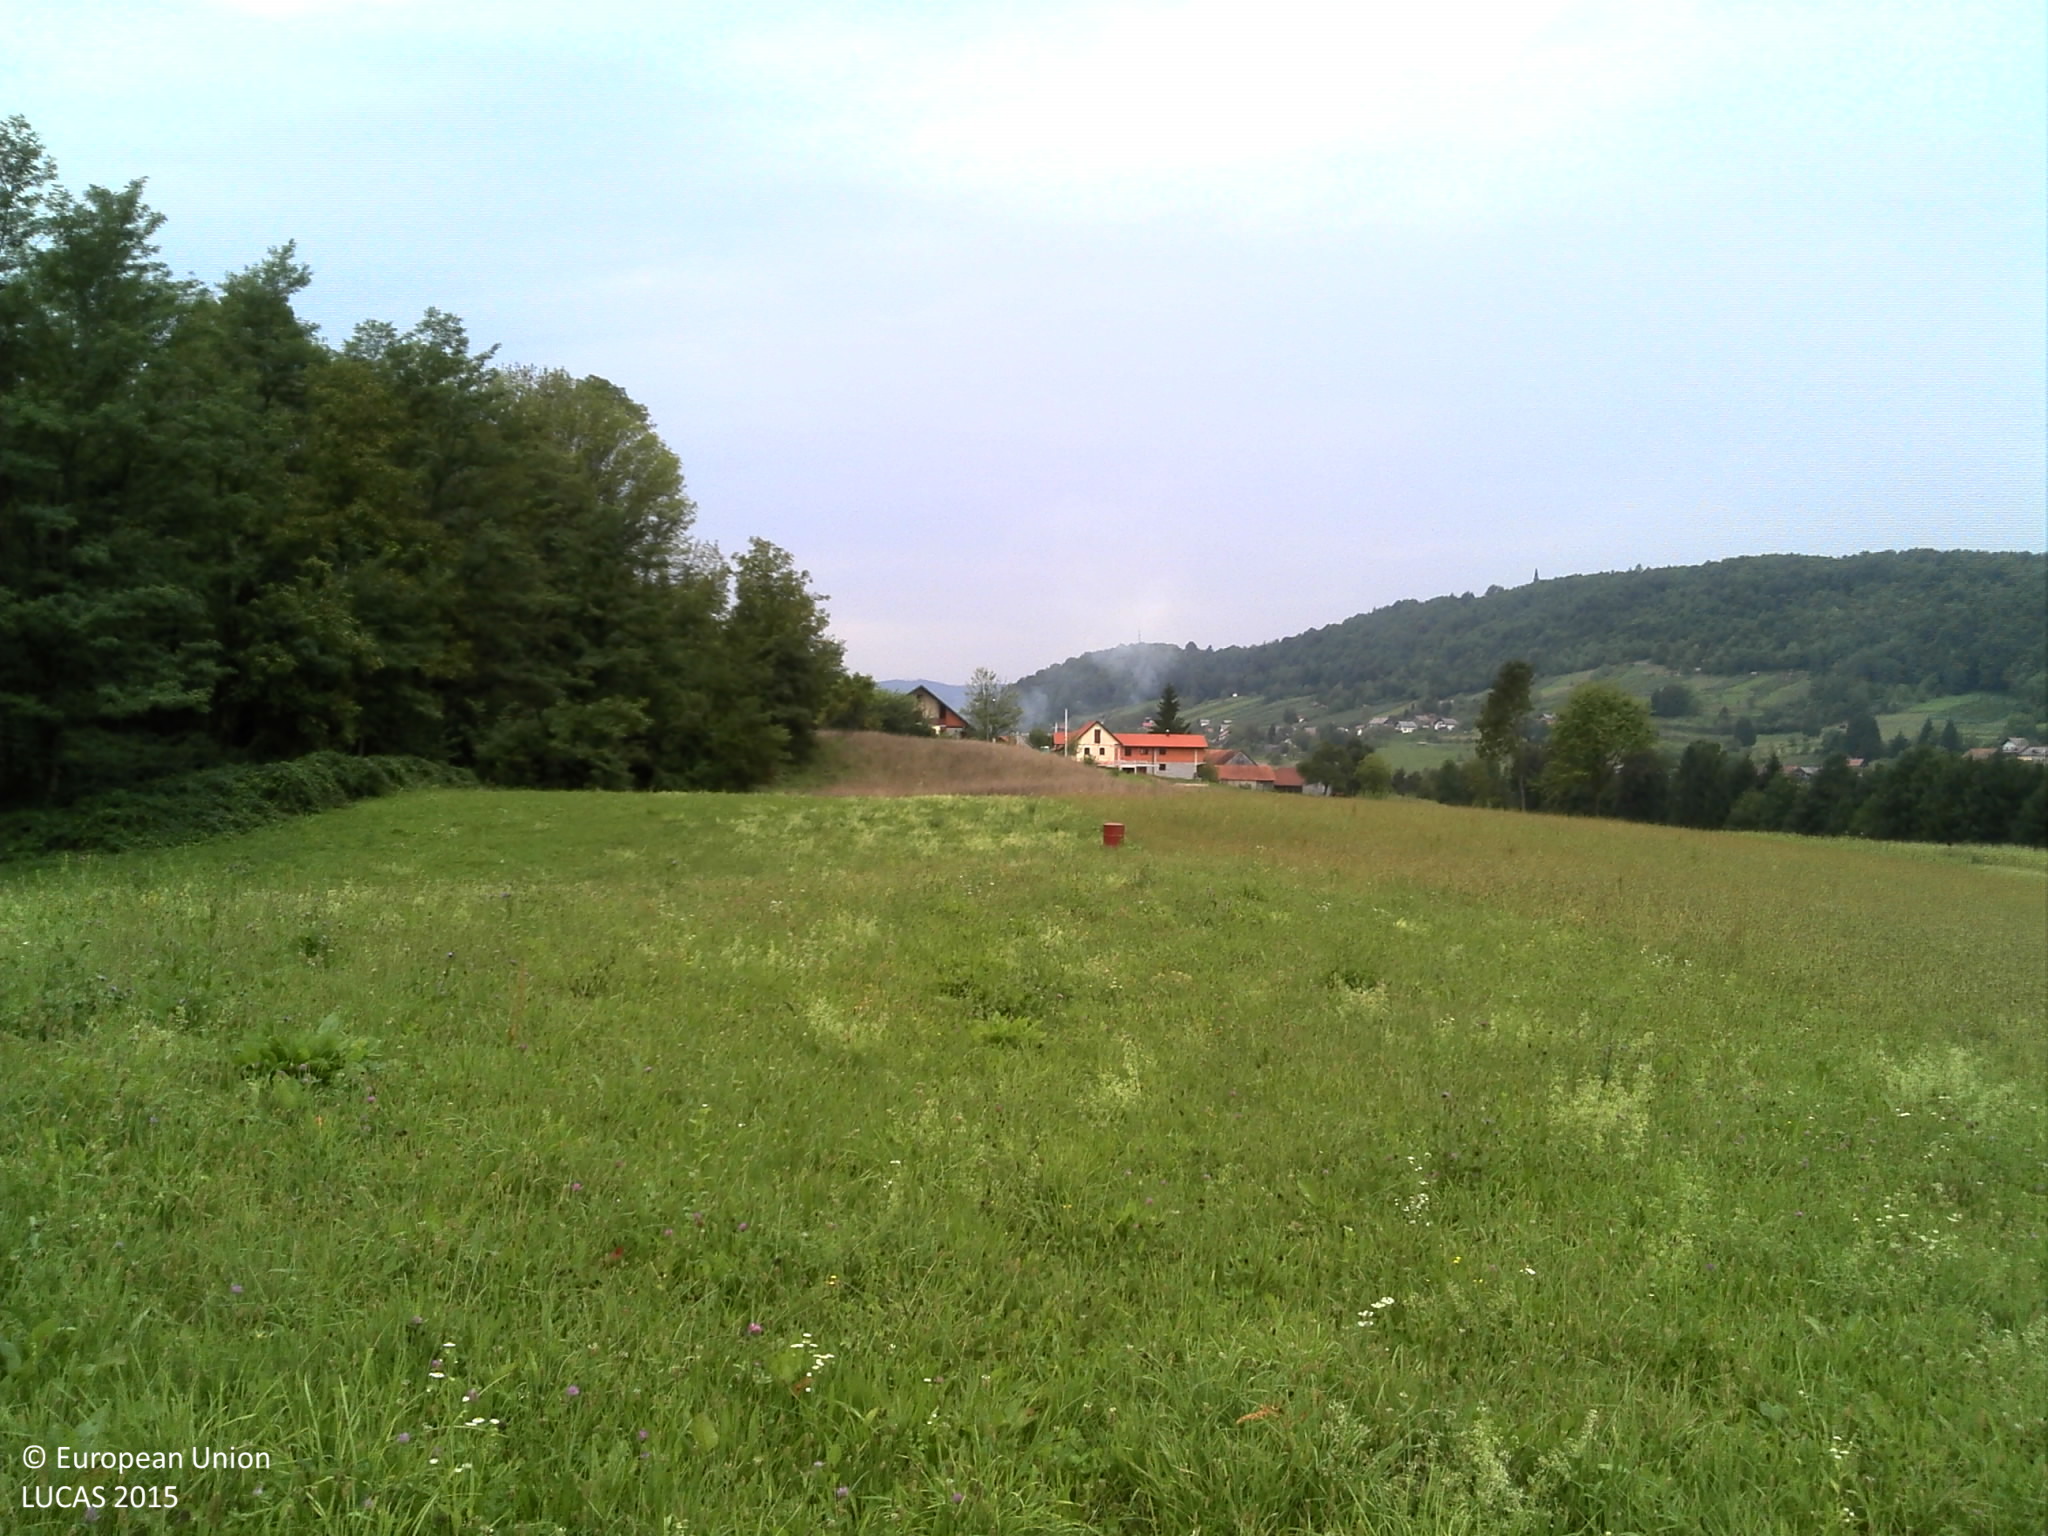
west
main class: Cropland
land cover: Clovers
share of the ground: > 75 %
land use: Agriculture (excluding fallow land and kitchen gardens)
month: September
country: HR
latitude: 45.4627
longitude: 15.2778
